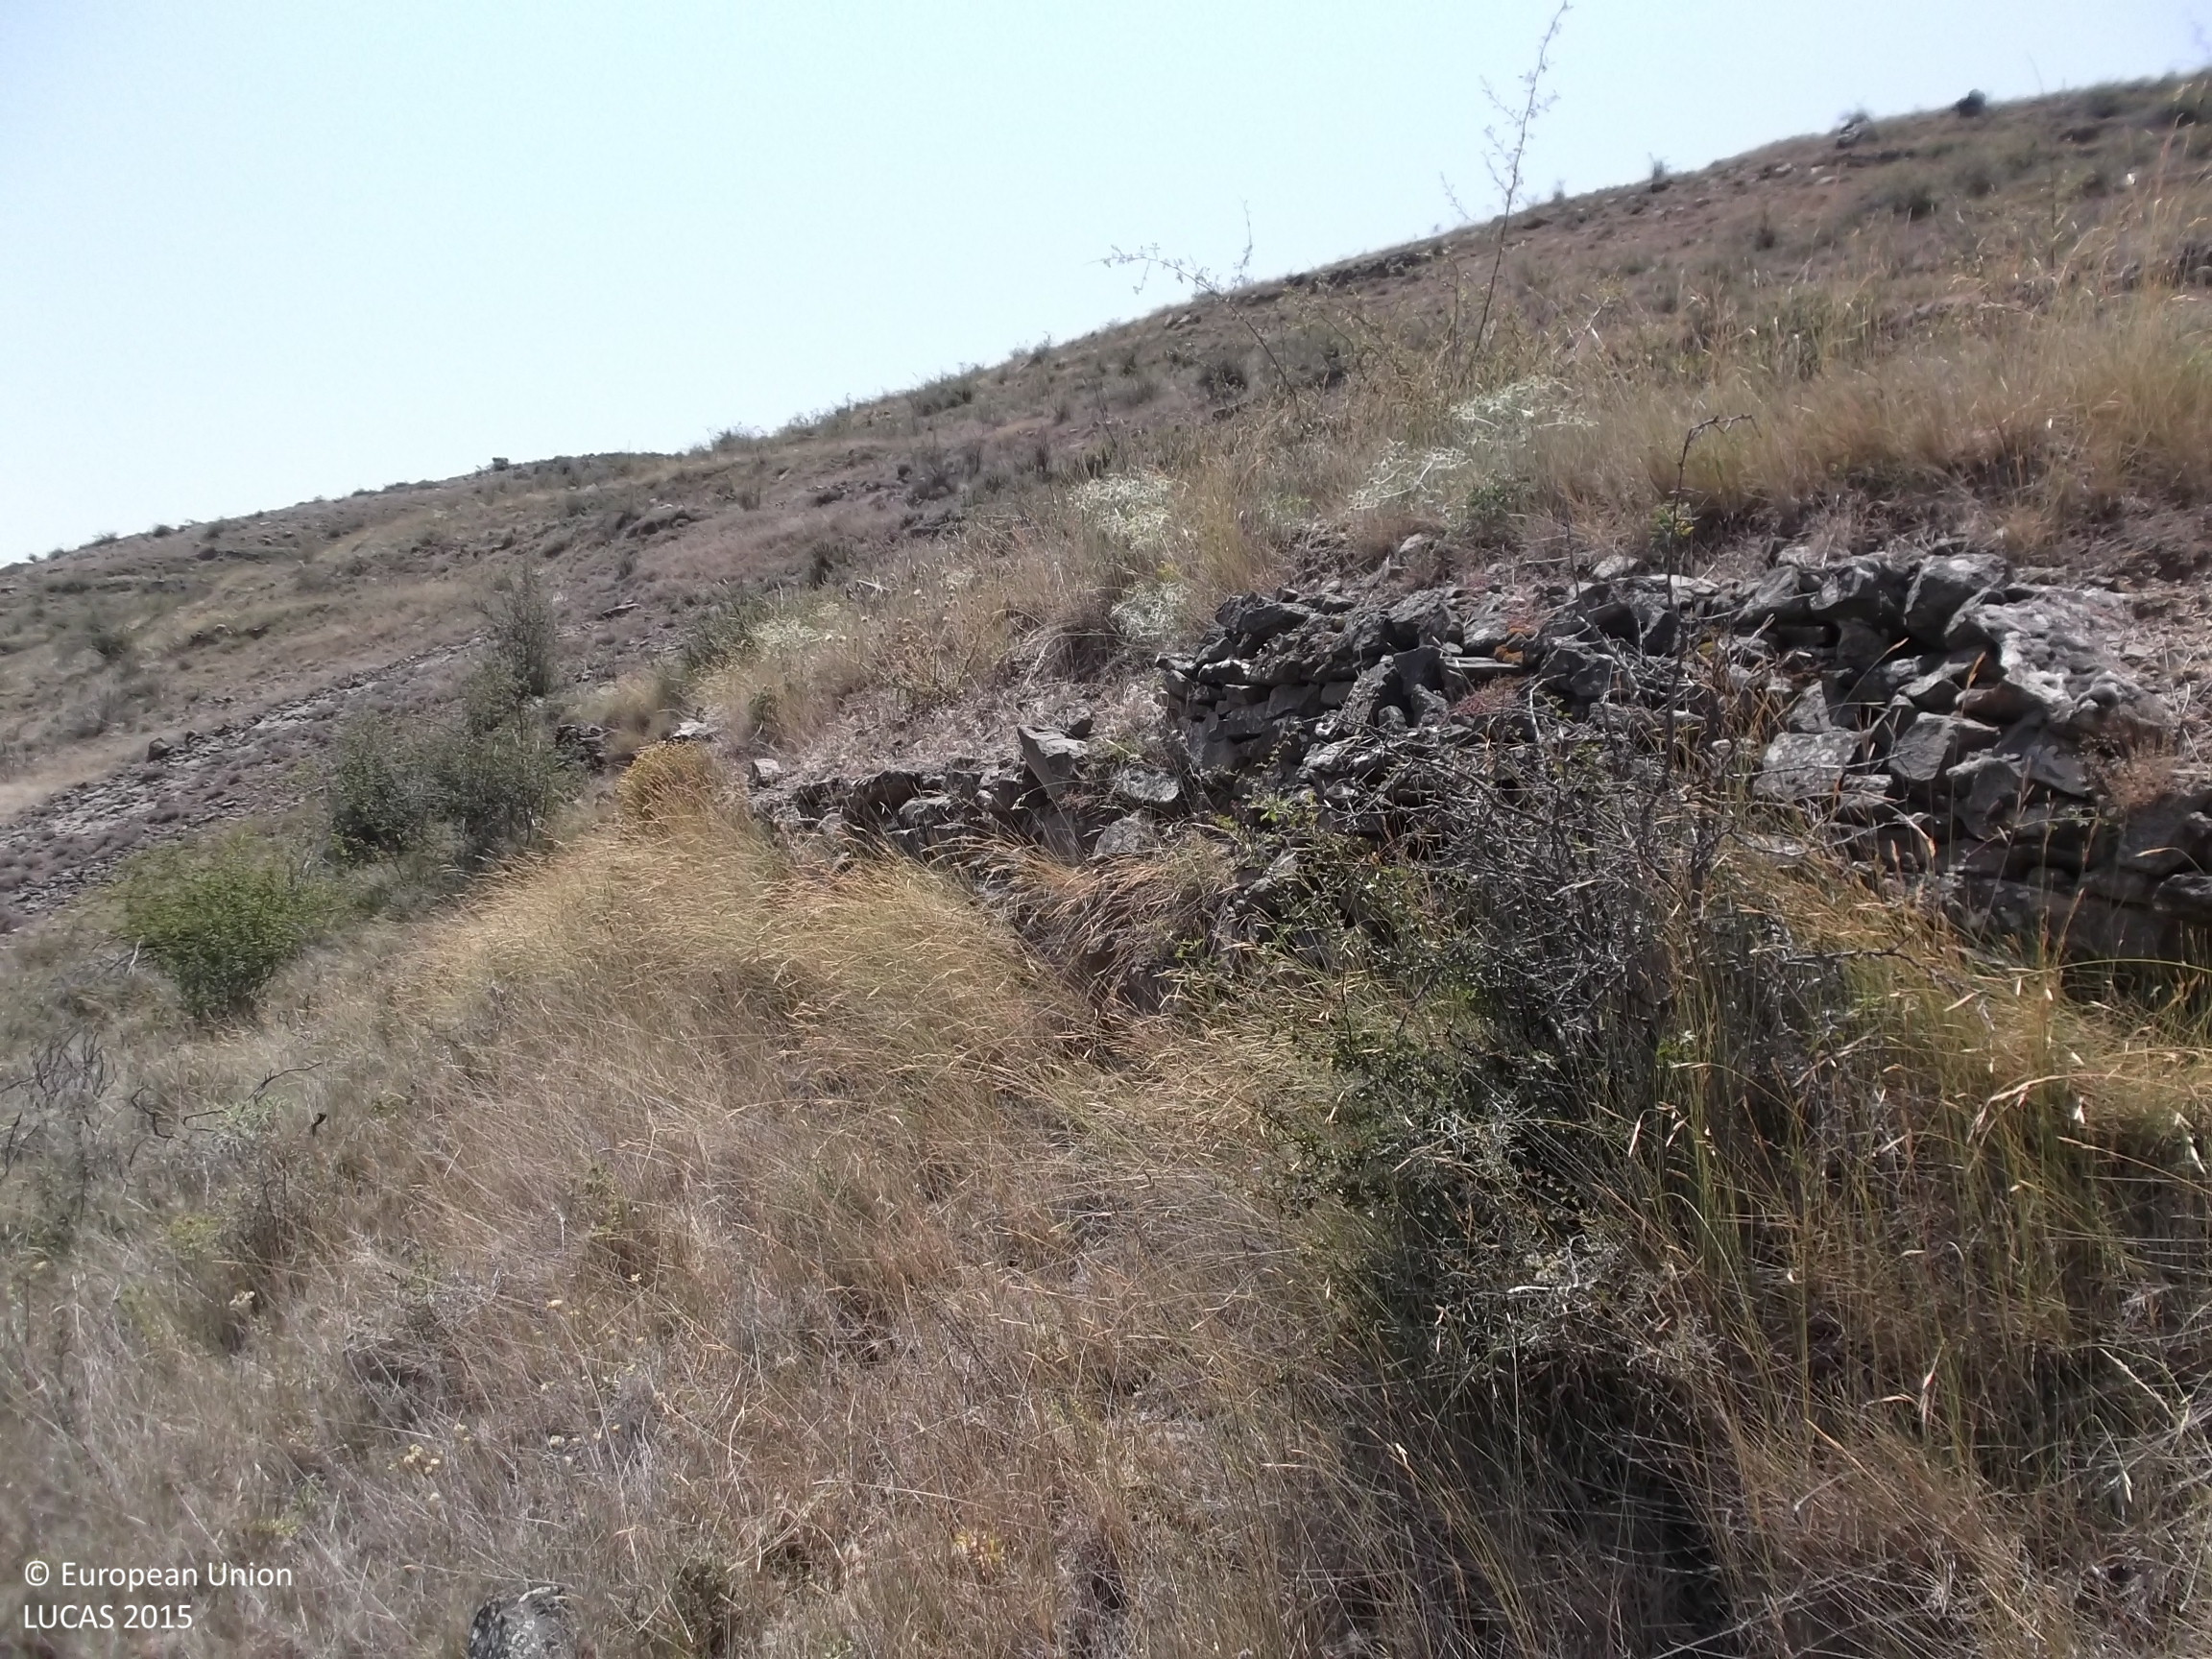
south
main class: Shrubland
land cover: Shrubland without tree cover
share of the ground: 50 - 75 %
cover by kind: shrubs 60 %, herbaceous plants 30 %, unconsolidated bare surface 10 %
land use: Agriculture (excluding fallow land and kitchen gardens)
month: July
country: ES
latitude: 42.0703
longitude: -2.1111
